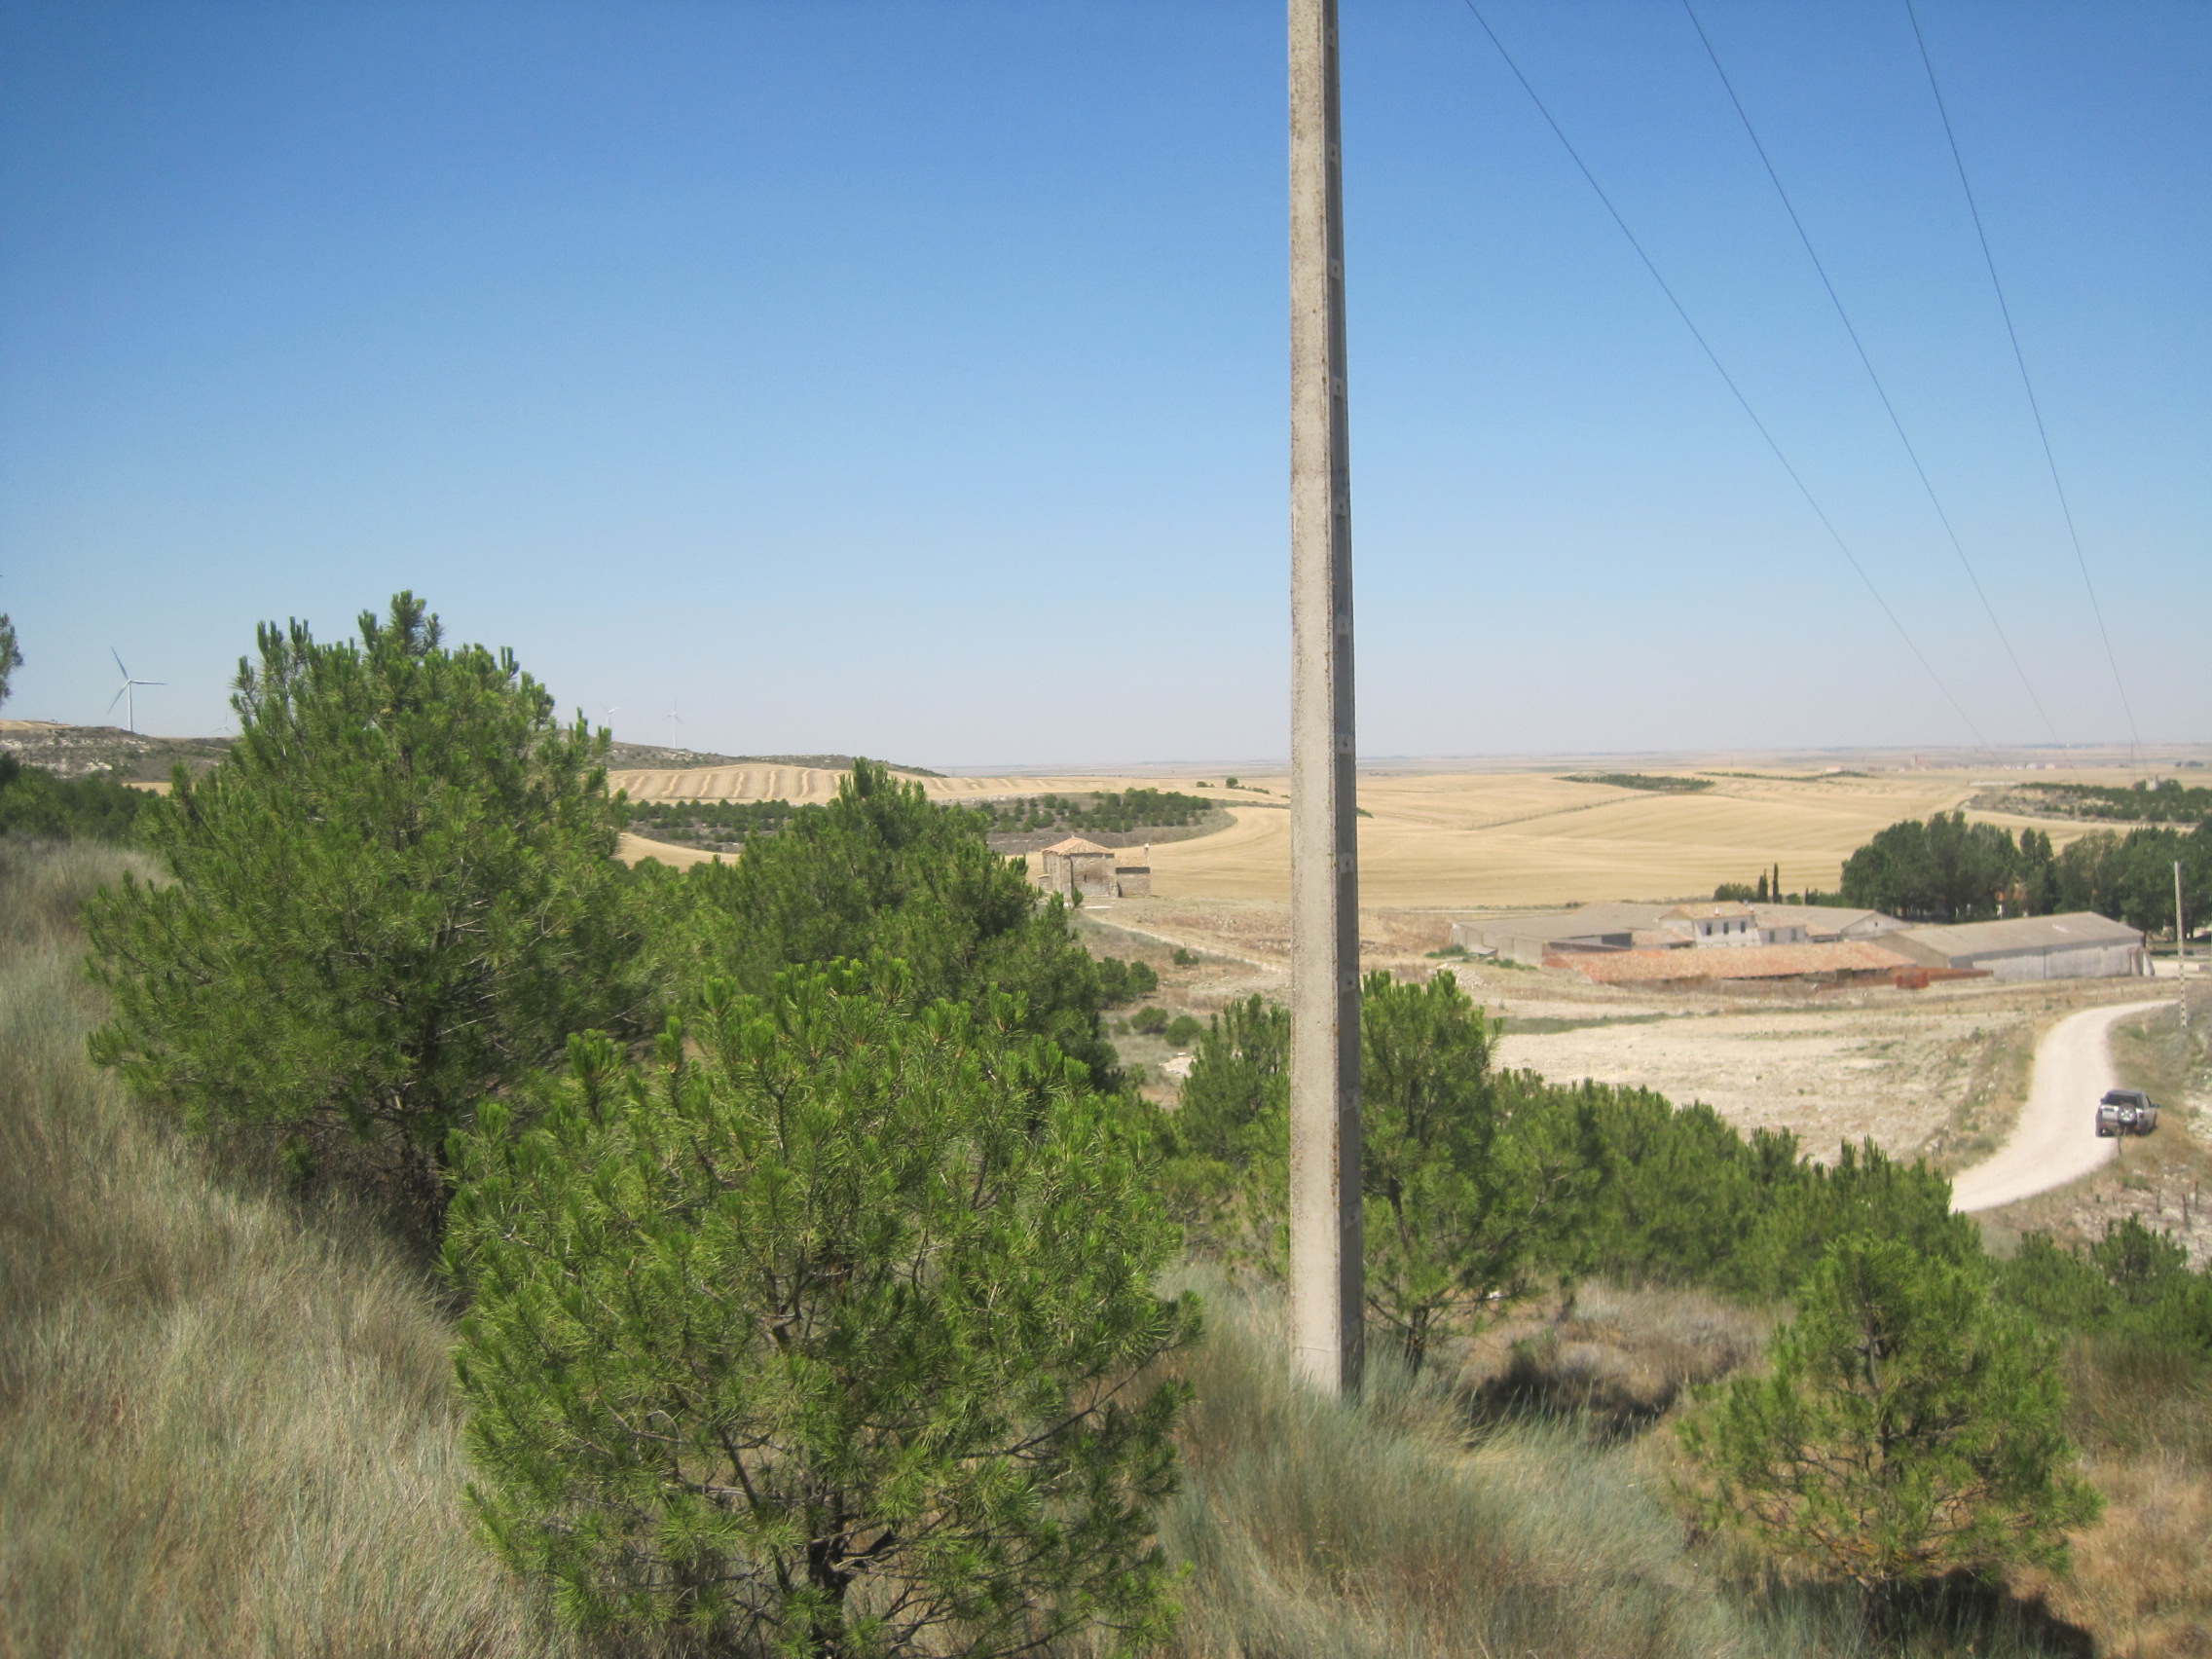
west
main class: Woodland
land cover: Pine dominated coniferous woodland
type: coniferous forest of the mediterranean region
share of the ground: 25 - 50 %
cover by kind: herbaceous plants 60 %, coniferous forest trees 40 %
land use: Semi-natural and natural areas not in use
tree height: > 5 m
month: July
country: ES
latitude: 41.9621
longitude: -4.6837
